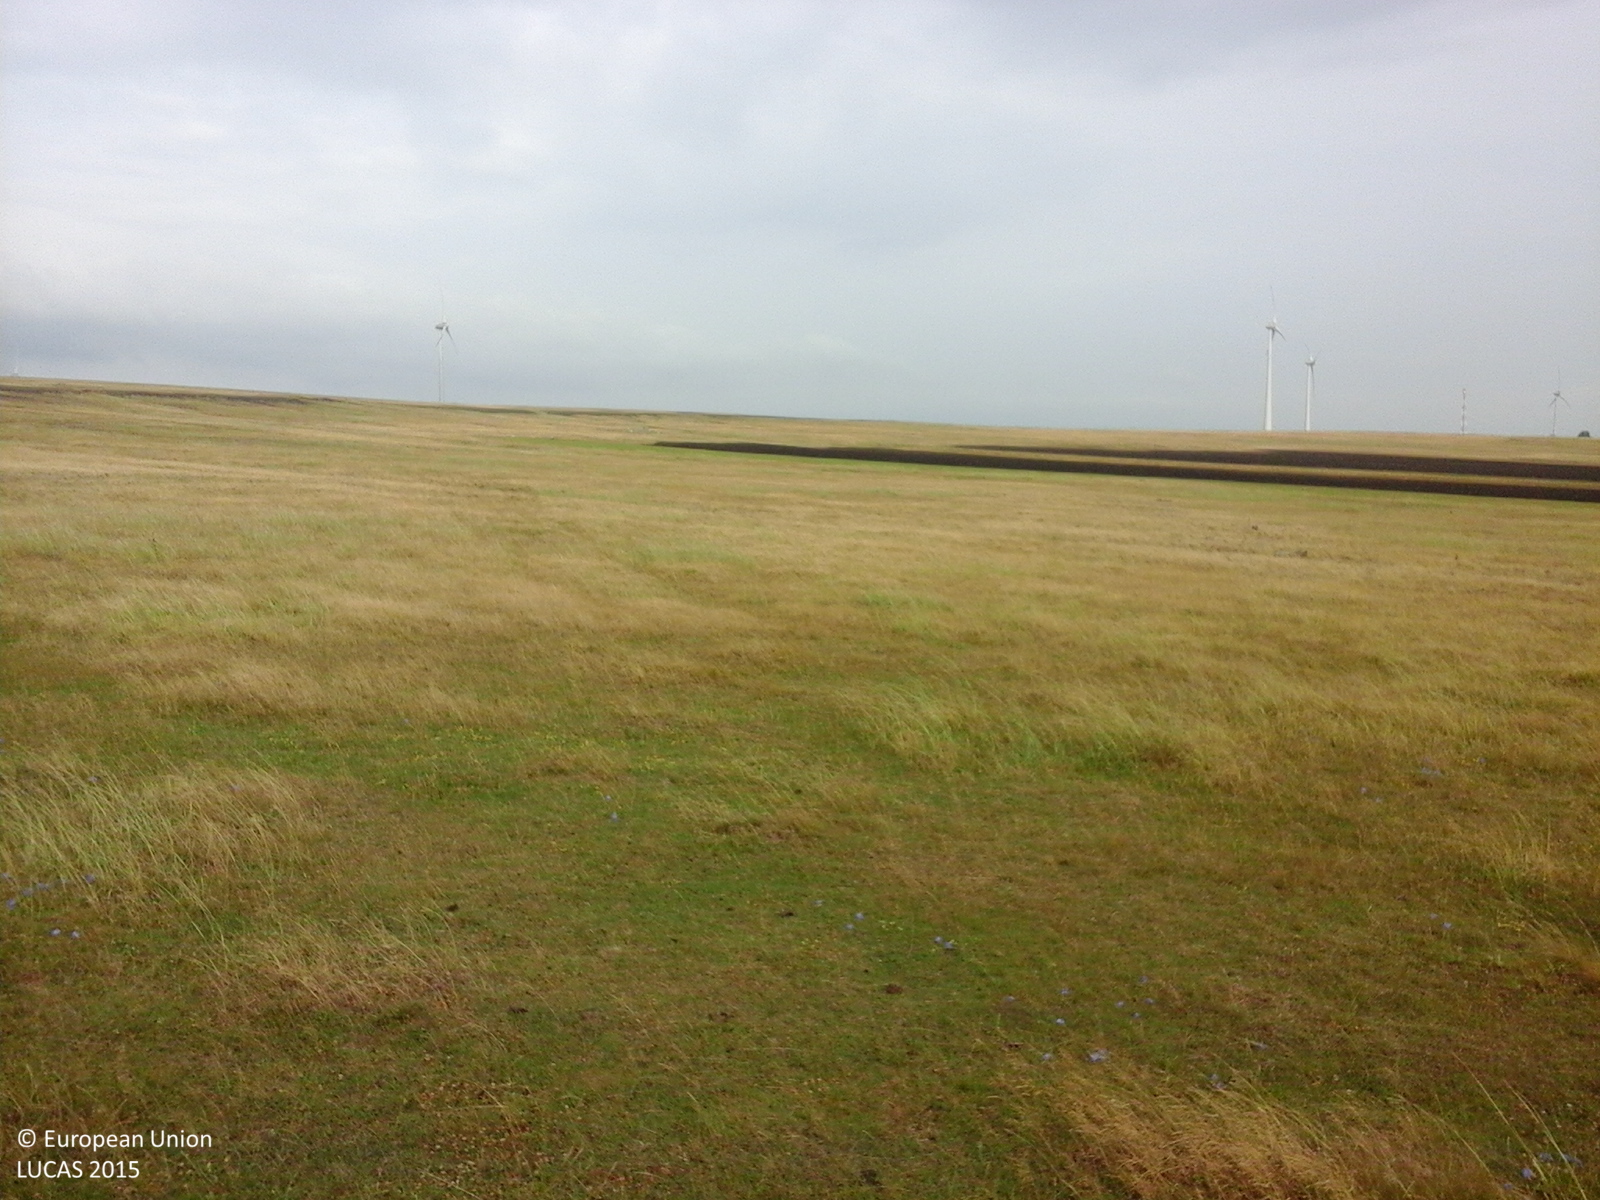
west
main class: Grassland
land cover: Grassland without tree/shrub cover
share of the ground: > 75 %
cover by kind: herbaceous plants 100 %
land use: Agriculture (excluding fallow land and kitchen gardens)
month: August
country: RO
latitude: 44.7588
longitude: 28.5859
